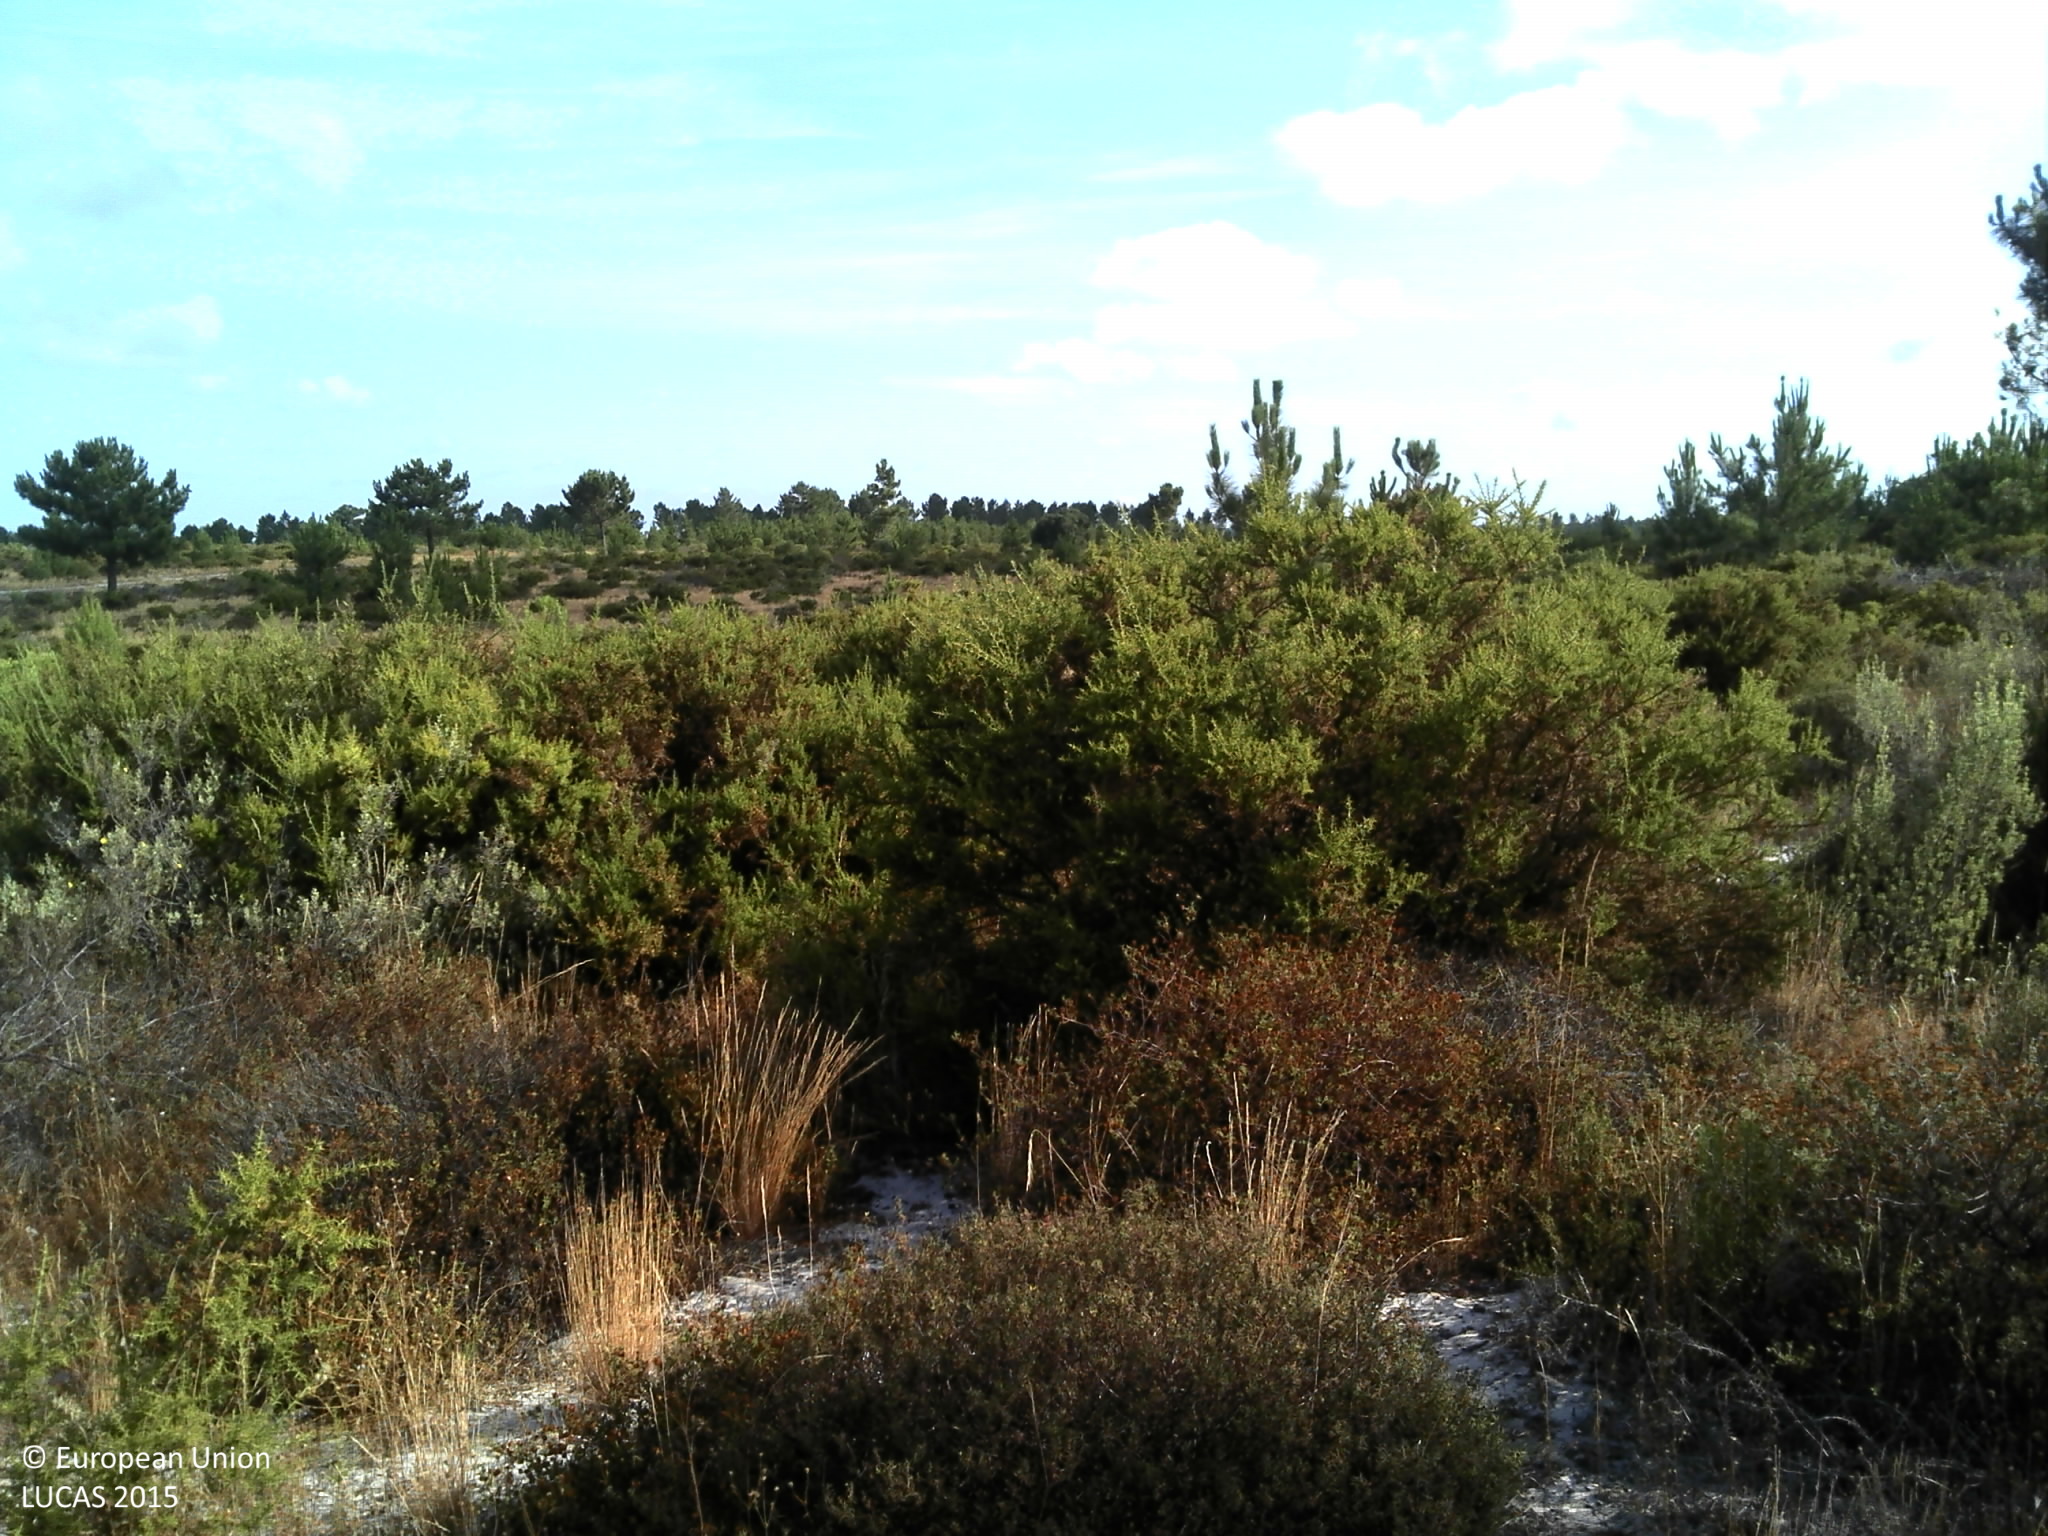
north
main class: Shrubland
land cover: Shrubland with sparse tree cover
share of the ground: 25 - 50 %
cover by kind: shrubs 40 %, unconsolidated bare surface 35 %, herbaceous plants 20 %, coniferous forest trees 5 %
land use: Semi-natural and natural areas not in use
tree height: < 5 m
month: July
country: PT
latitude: 38.5022
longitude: -9.0926
